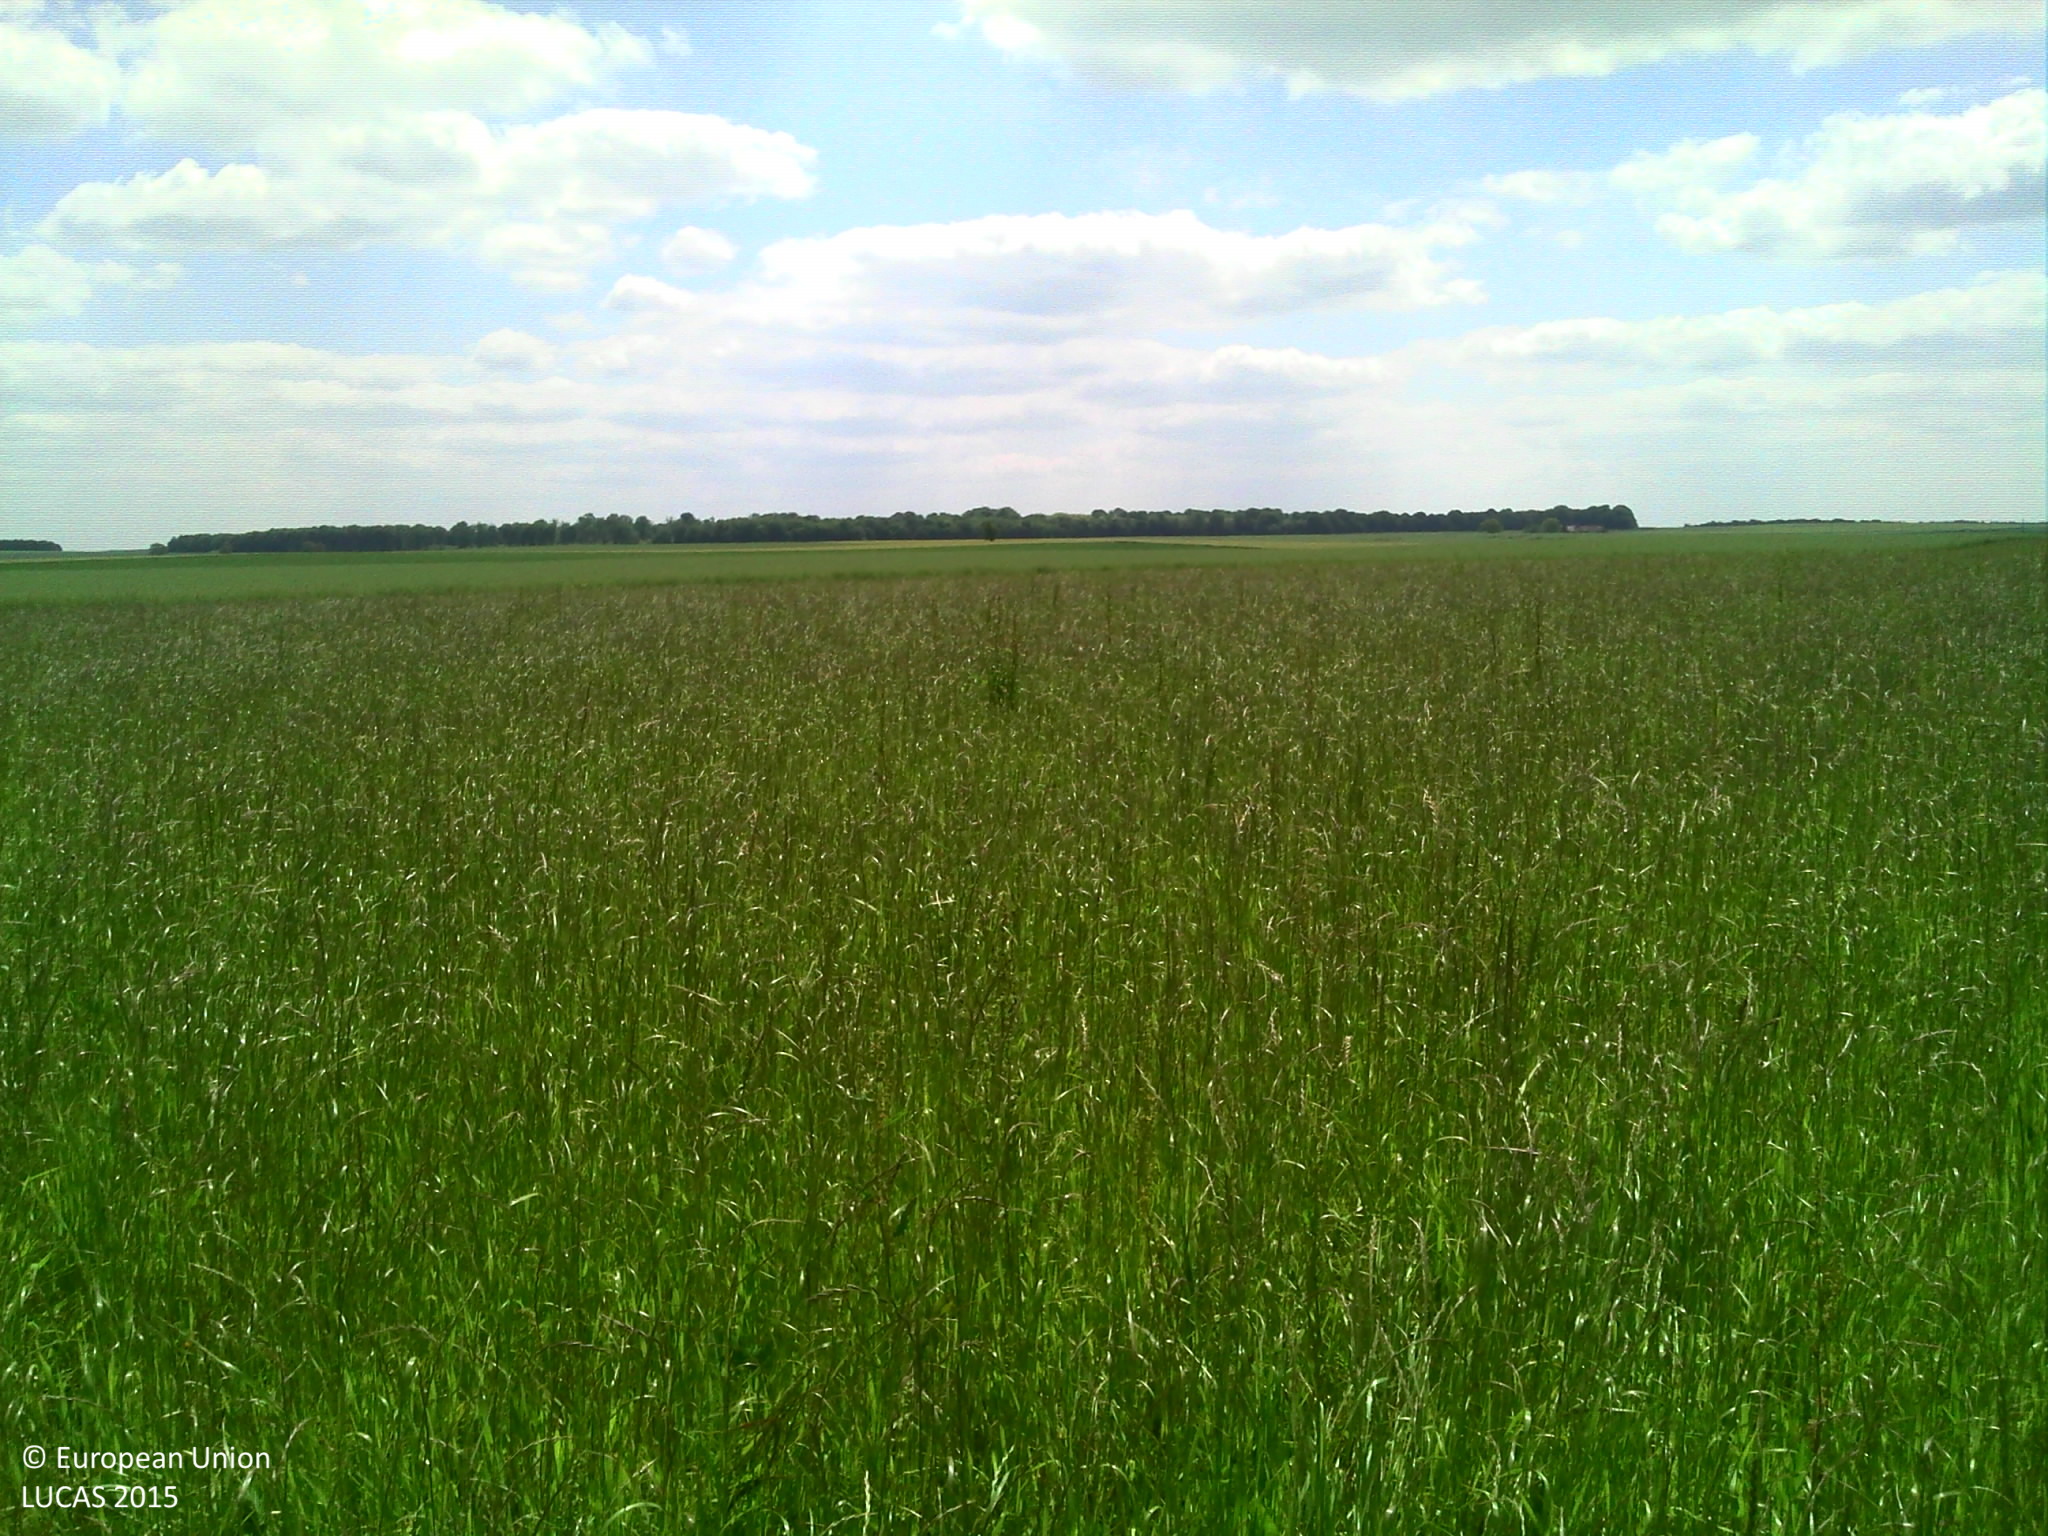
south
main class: Cropland
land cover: Temporary grasslands
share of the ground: > 75 %
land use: Agriculture (excluding fallow land and kitchen gardens)
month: May
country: FR
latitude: 47.7694
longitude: 4.3004
